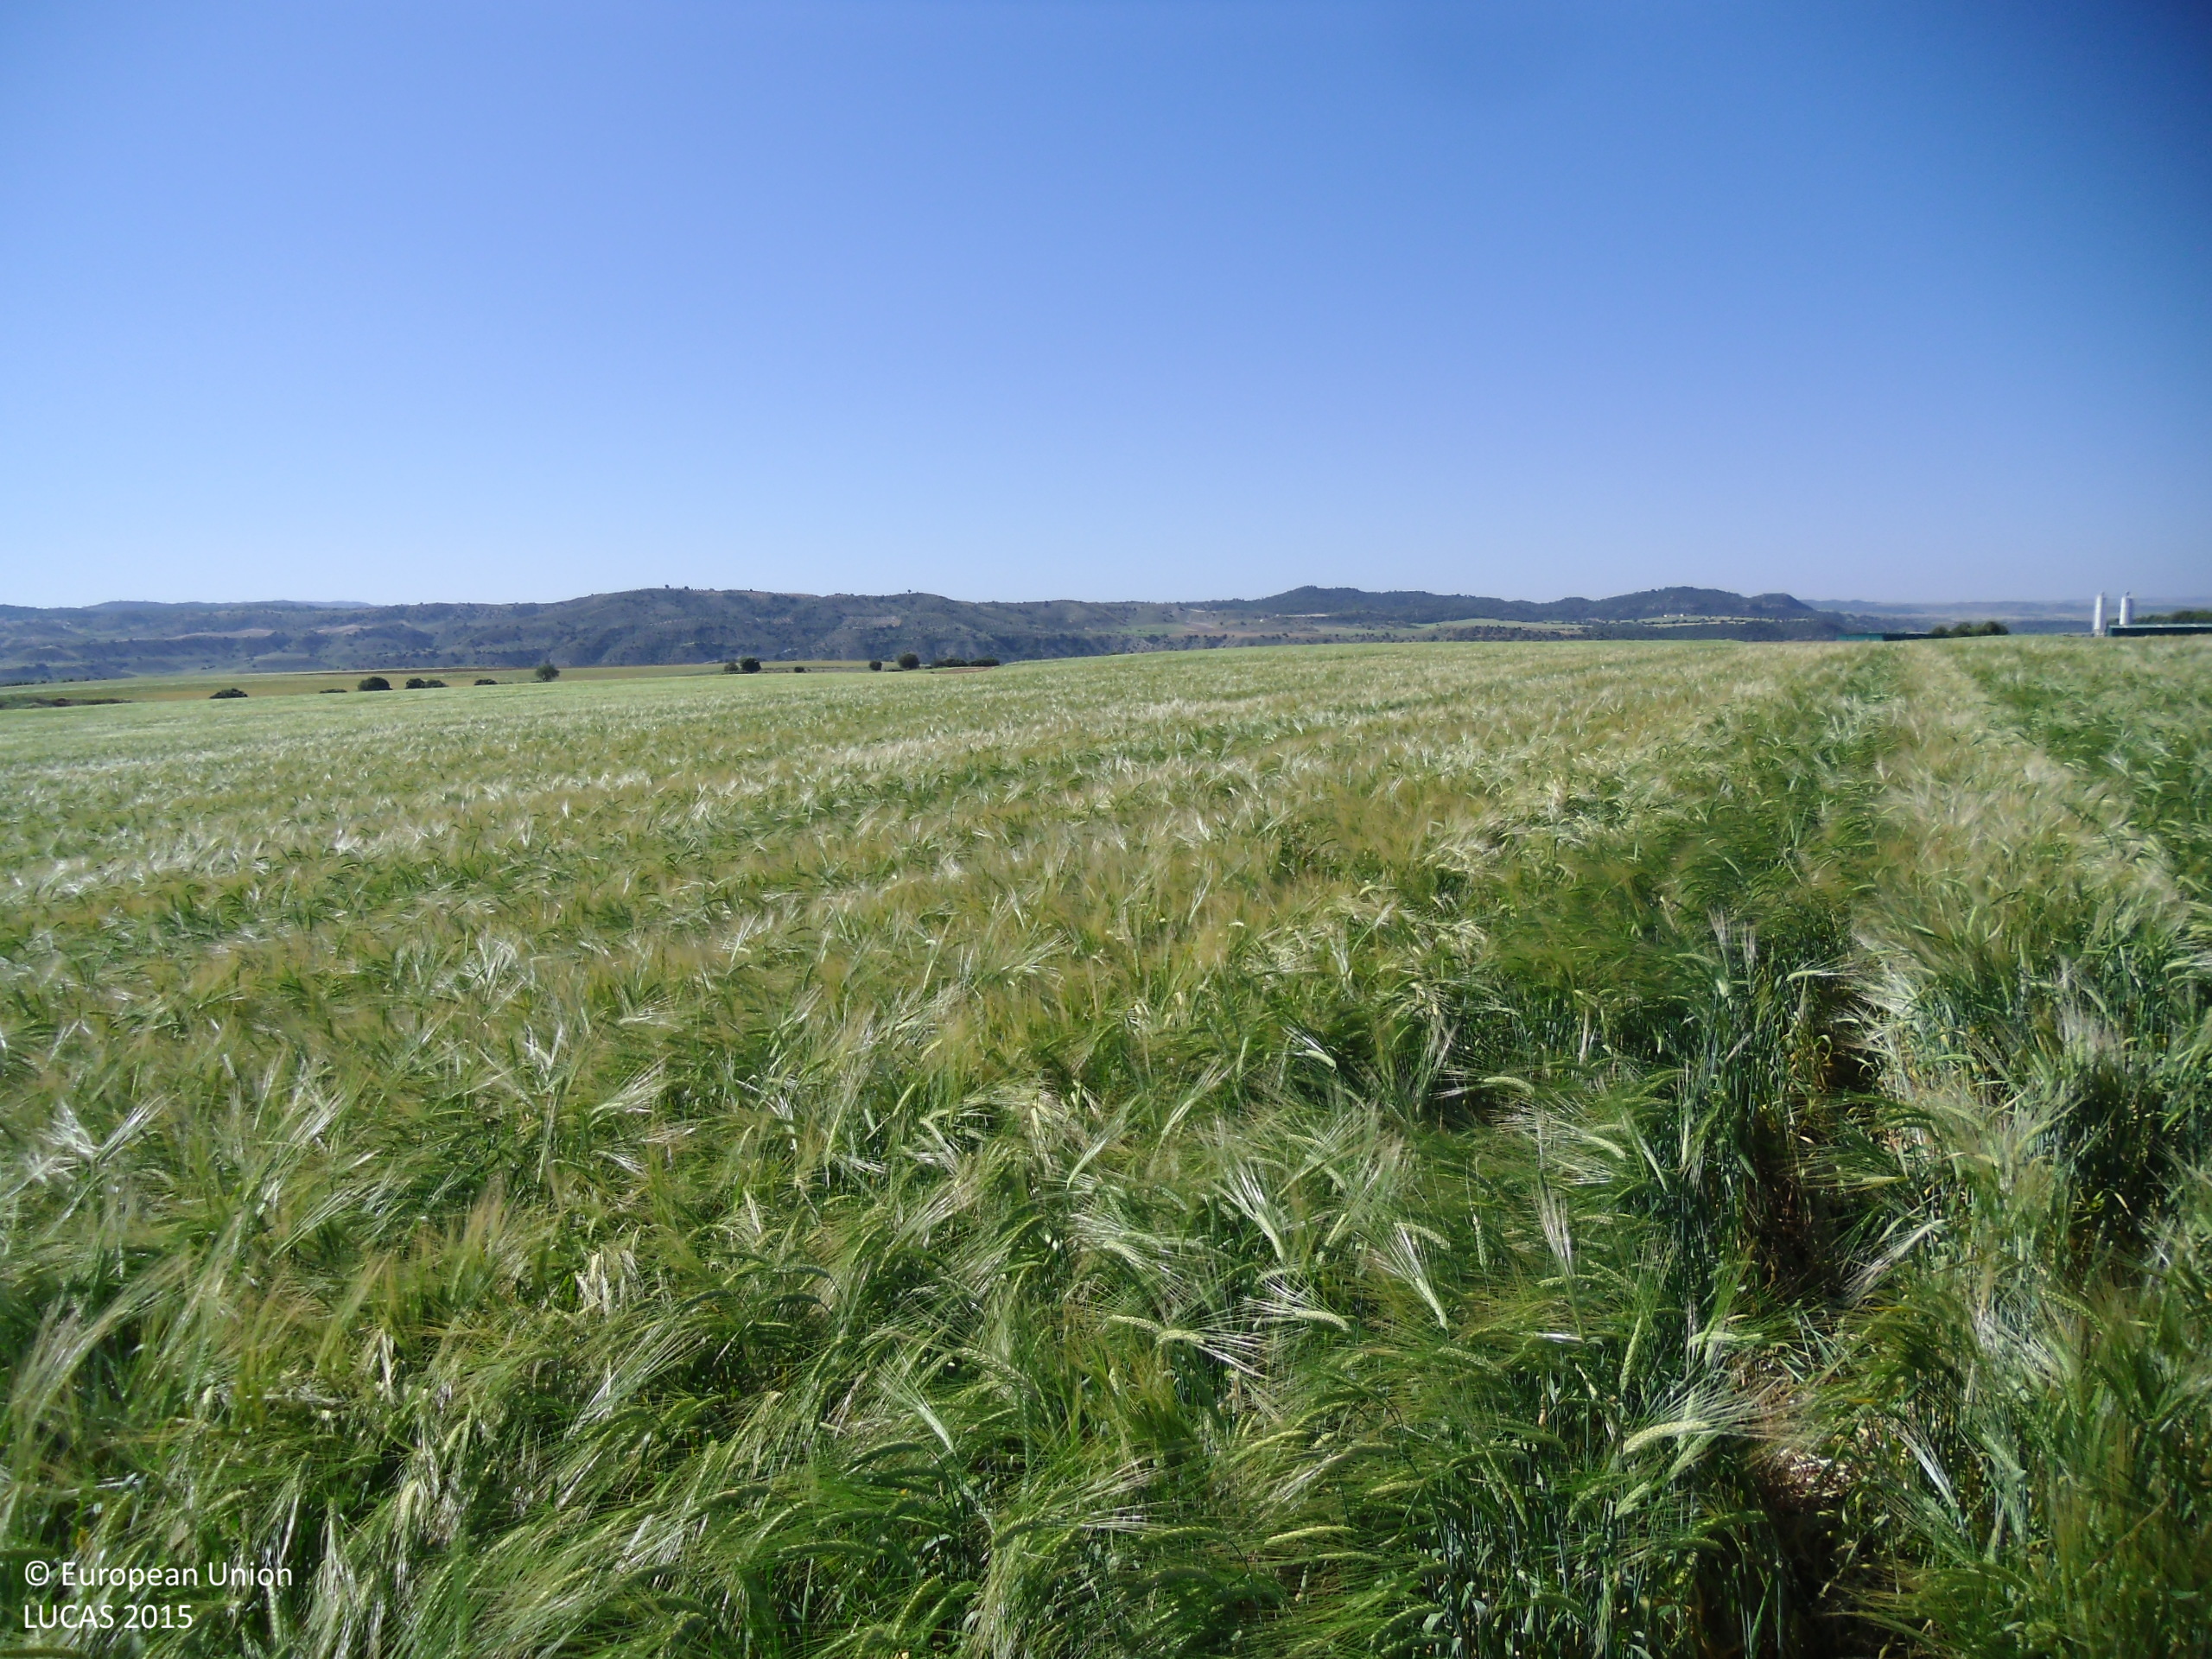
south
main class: Cropland
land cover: Barley
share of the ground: > 75 %
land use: Agriculture (excluding fallow land and kitchen gardens)
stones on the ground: < 10 %
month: May
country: ES
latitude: 40.3007
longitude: -2.9566
